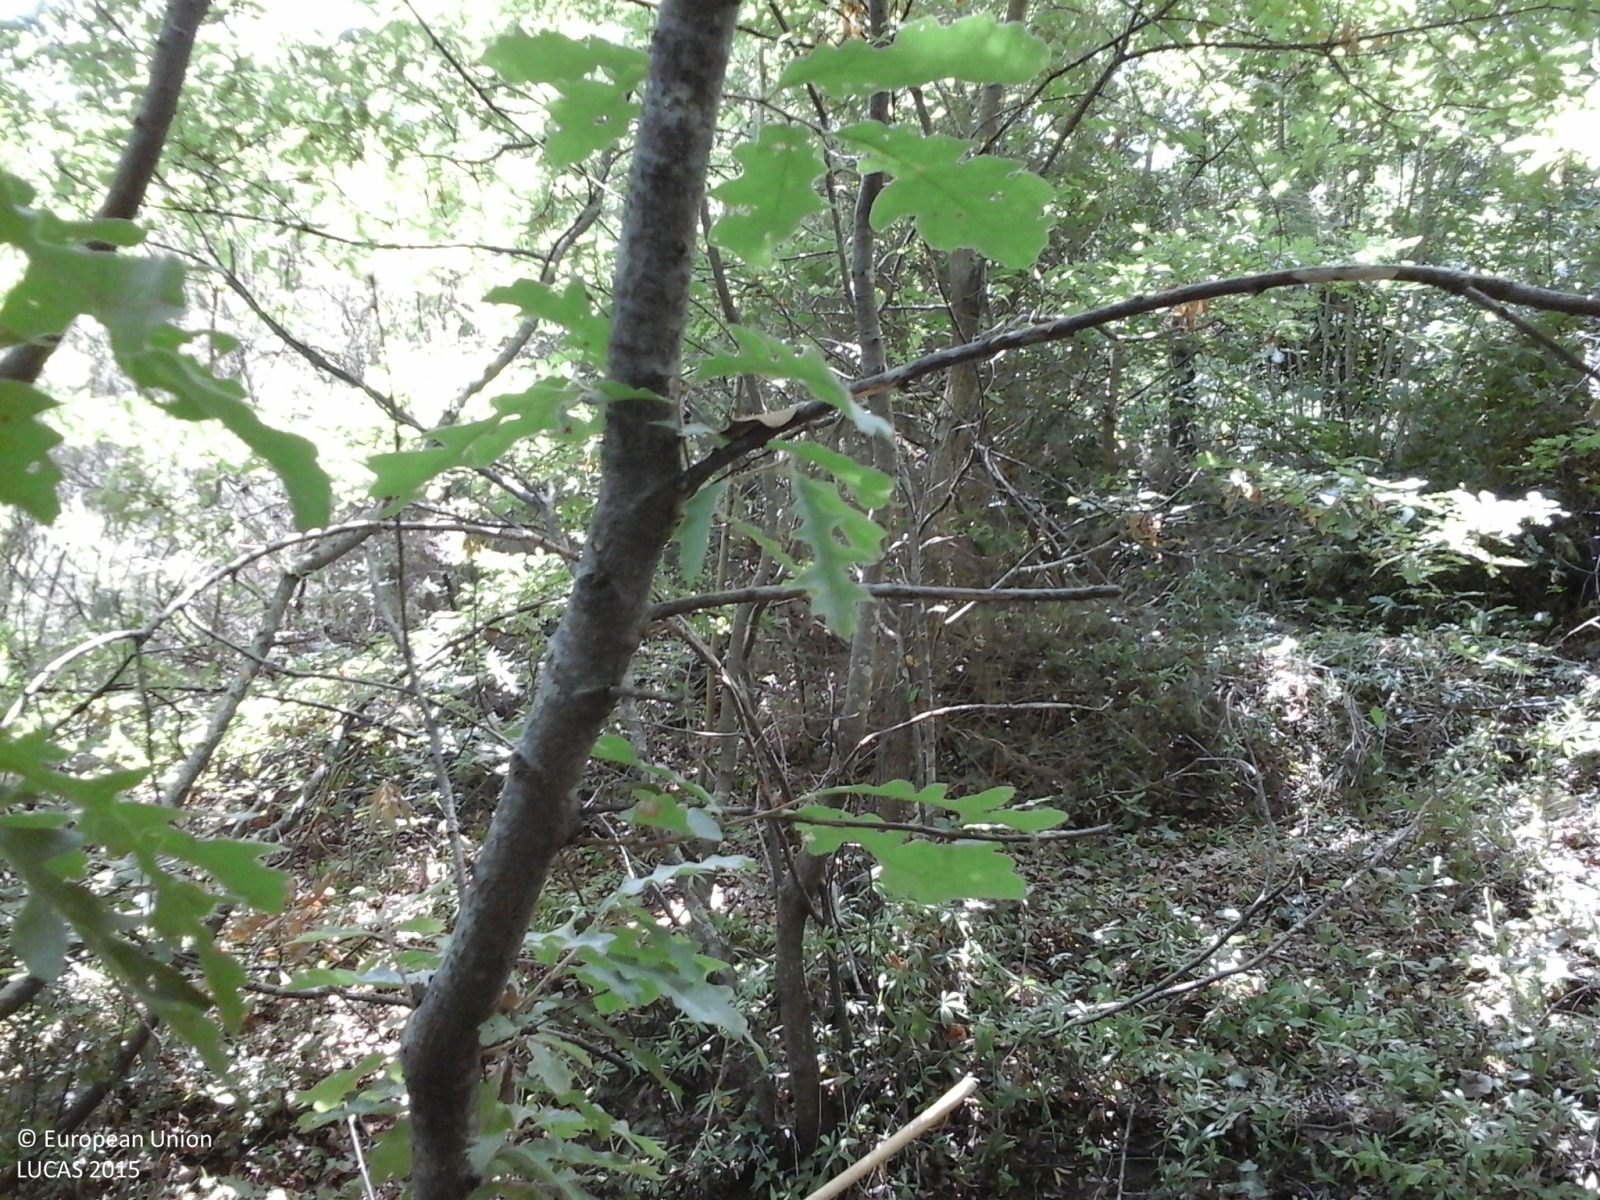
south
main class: Woodland
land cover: Broadleaved woodland
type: thermophilous deciduous forest
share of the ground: > 75 %
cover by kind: broadleaved forest trees 90 %, shrubs 10 %
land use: Forestry
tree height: > 5 m
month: July
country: IT
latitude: 43.0277
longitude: 11.0644
